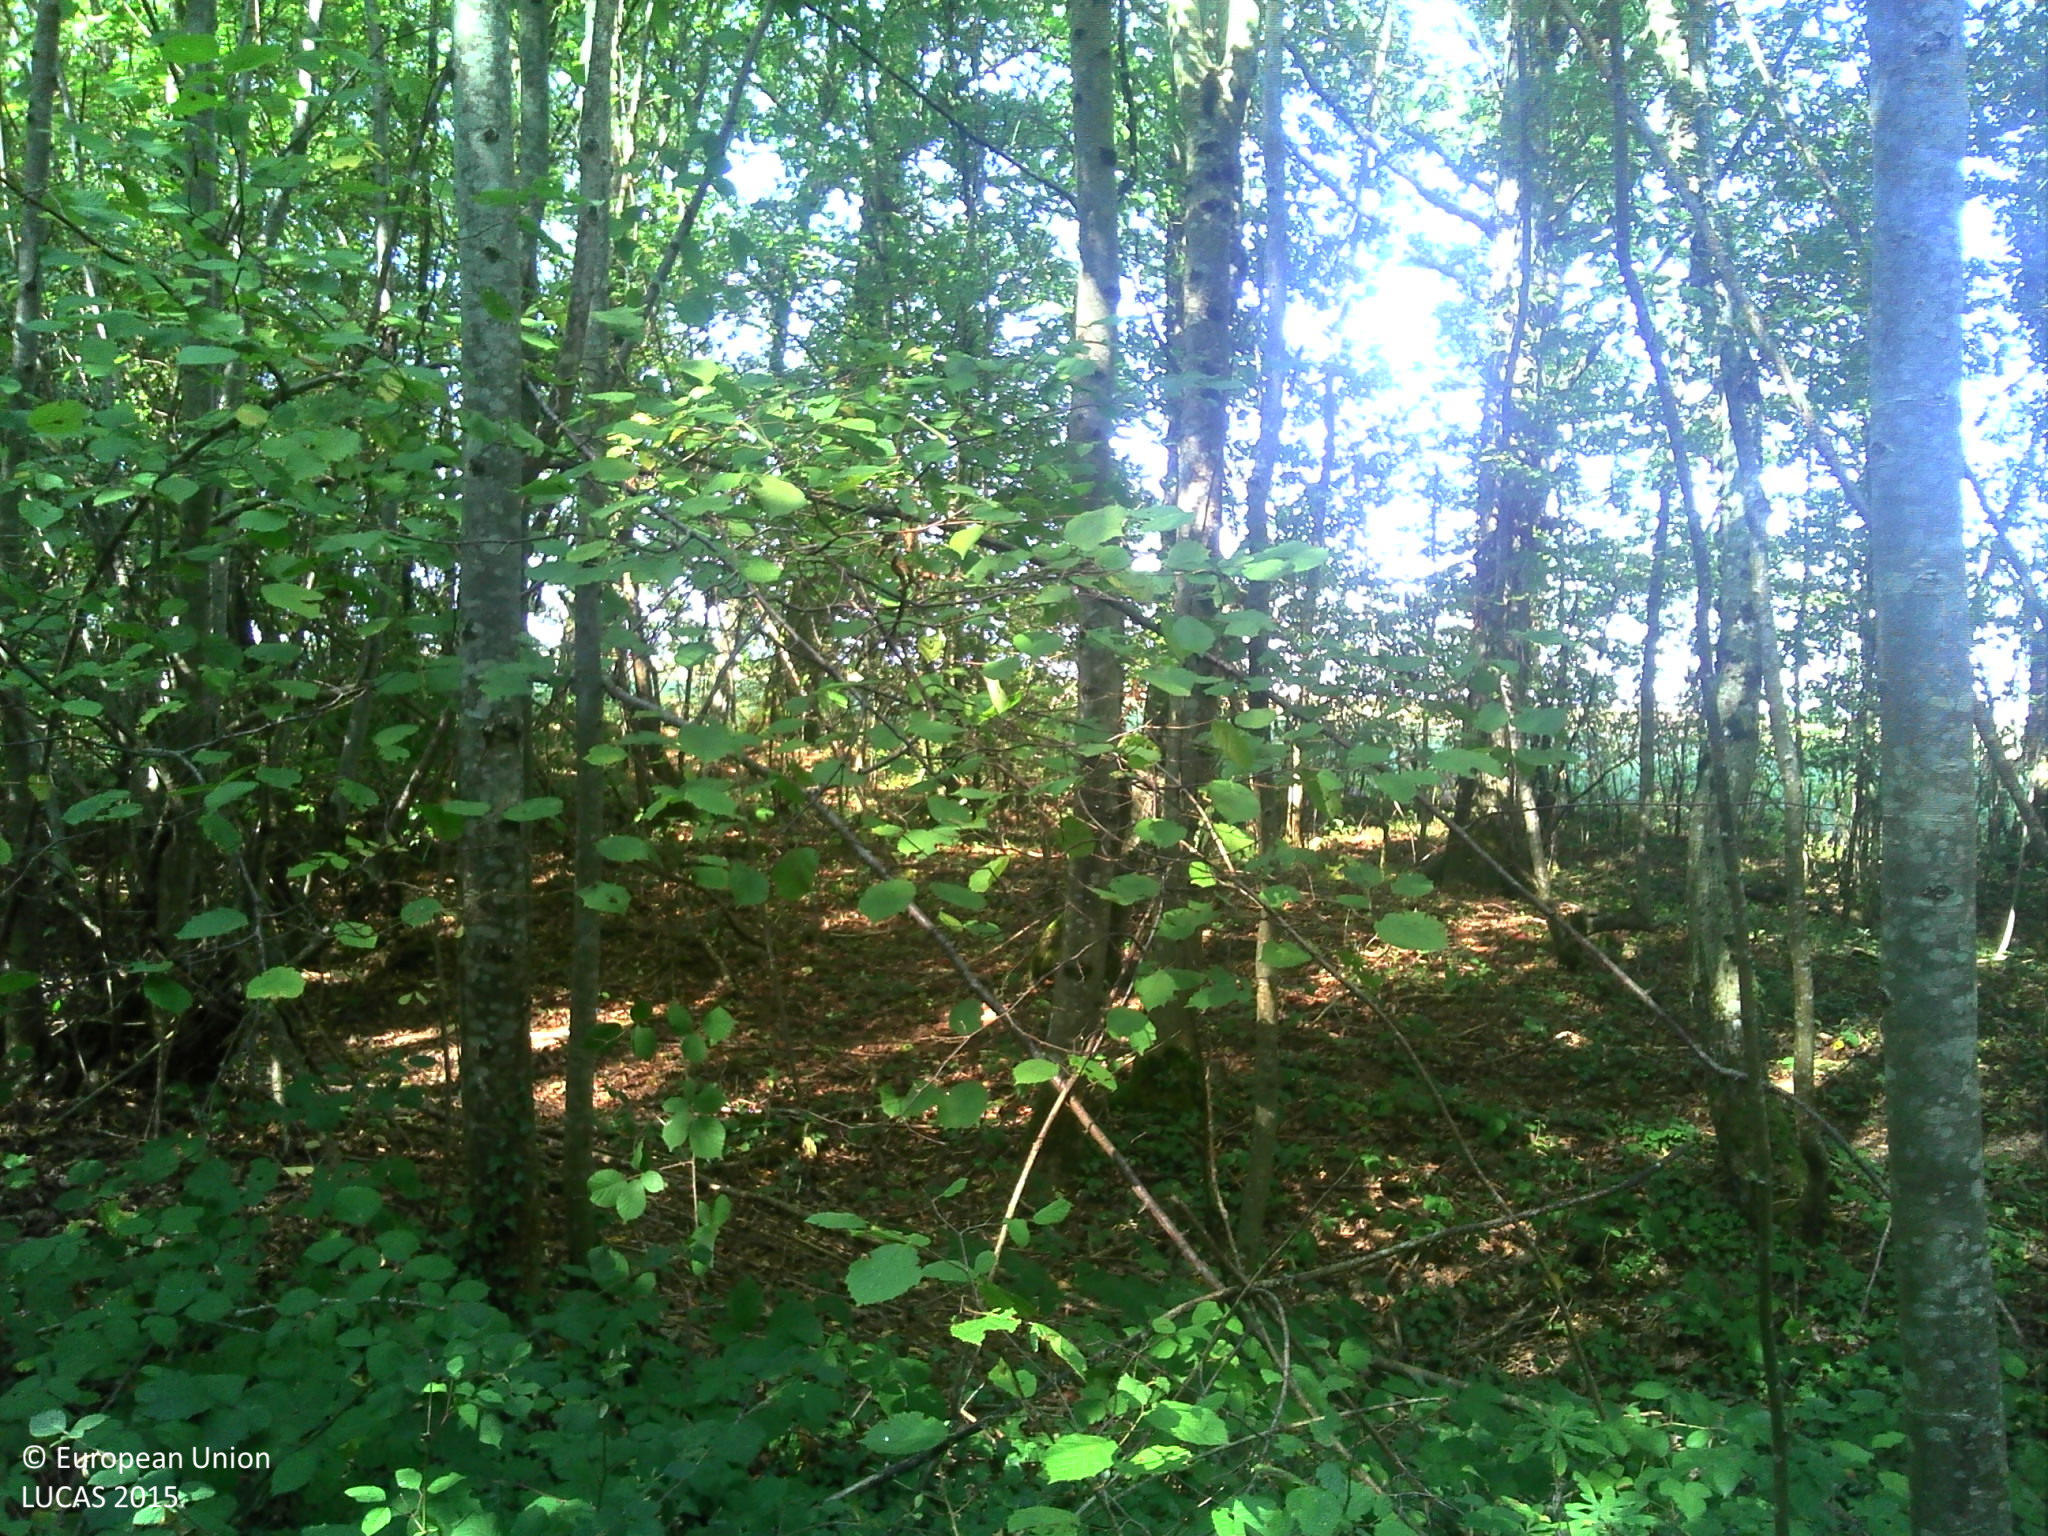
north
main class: Woodland
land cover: Broadleaved woodland
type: mesophytic deciduous forest
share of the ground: > 75 %
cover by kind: broadleaved forest trees 85 %, herbaceous plants 10 %, consolidated bare surface 5 %
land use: Forestry
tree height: > 5 m
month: September
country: FR
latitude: 48.8093
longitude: 6.2826
